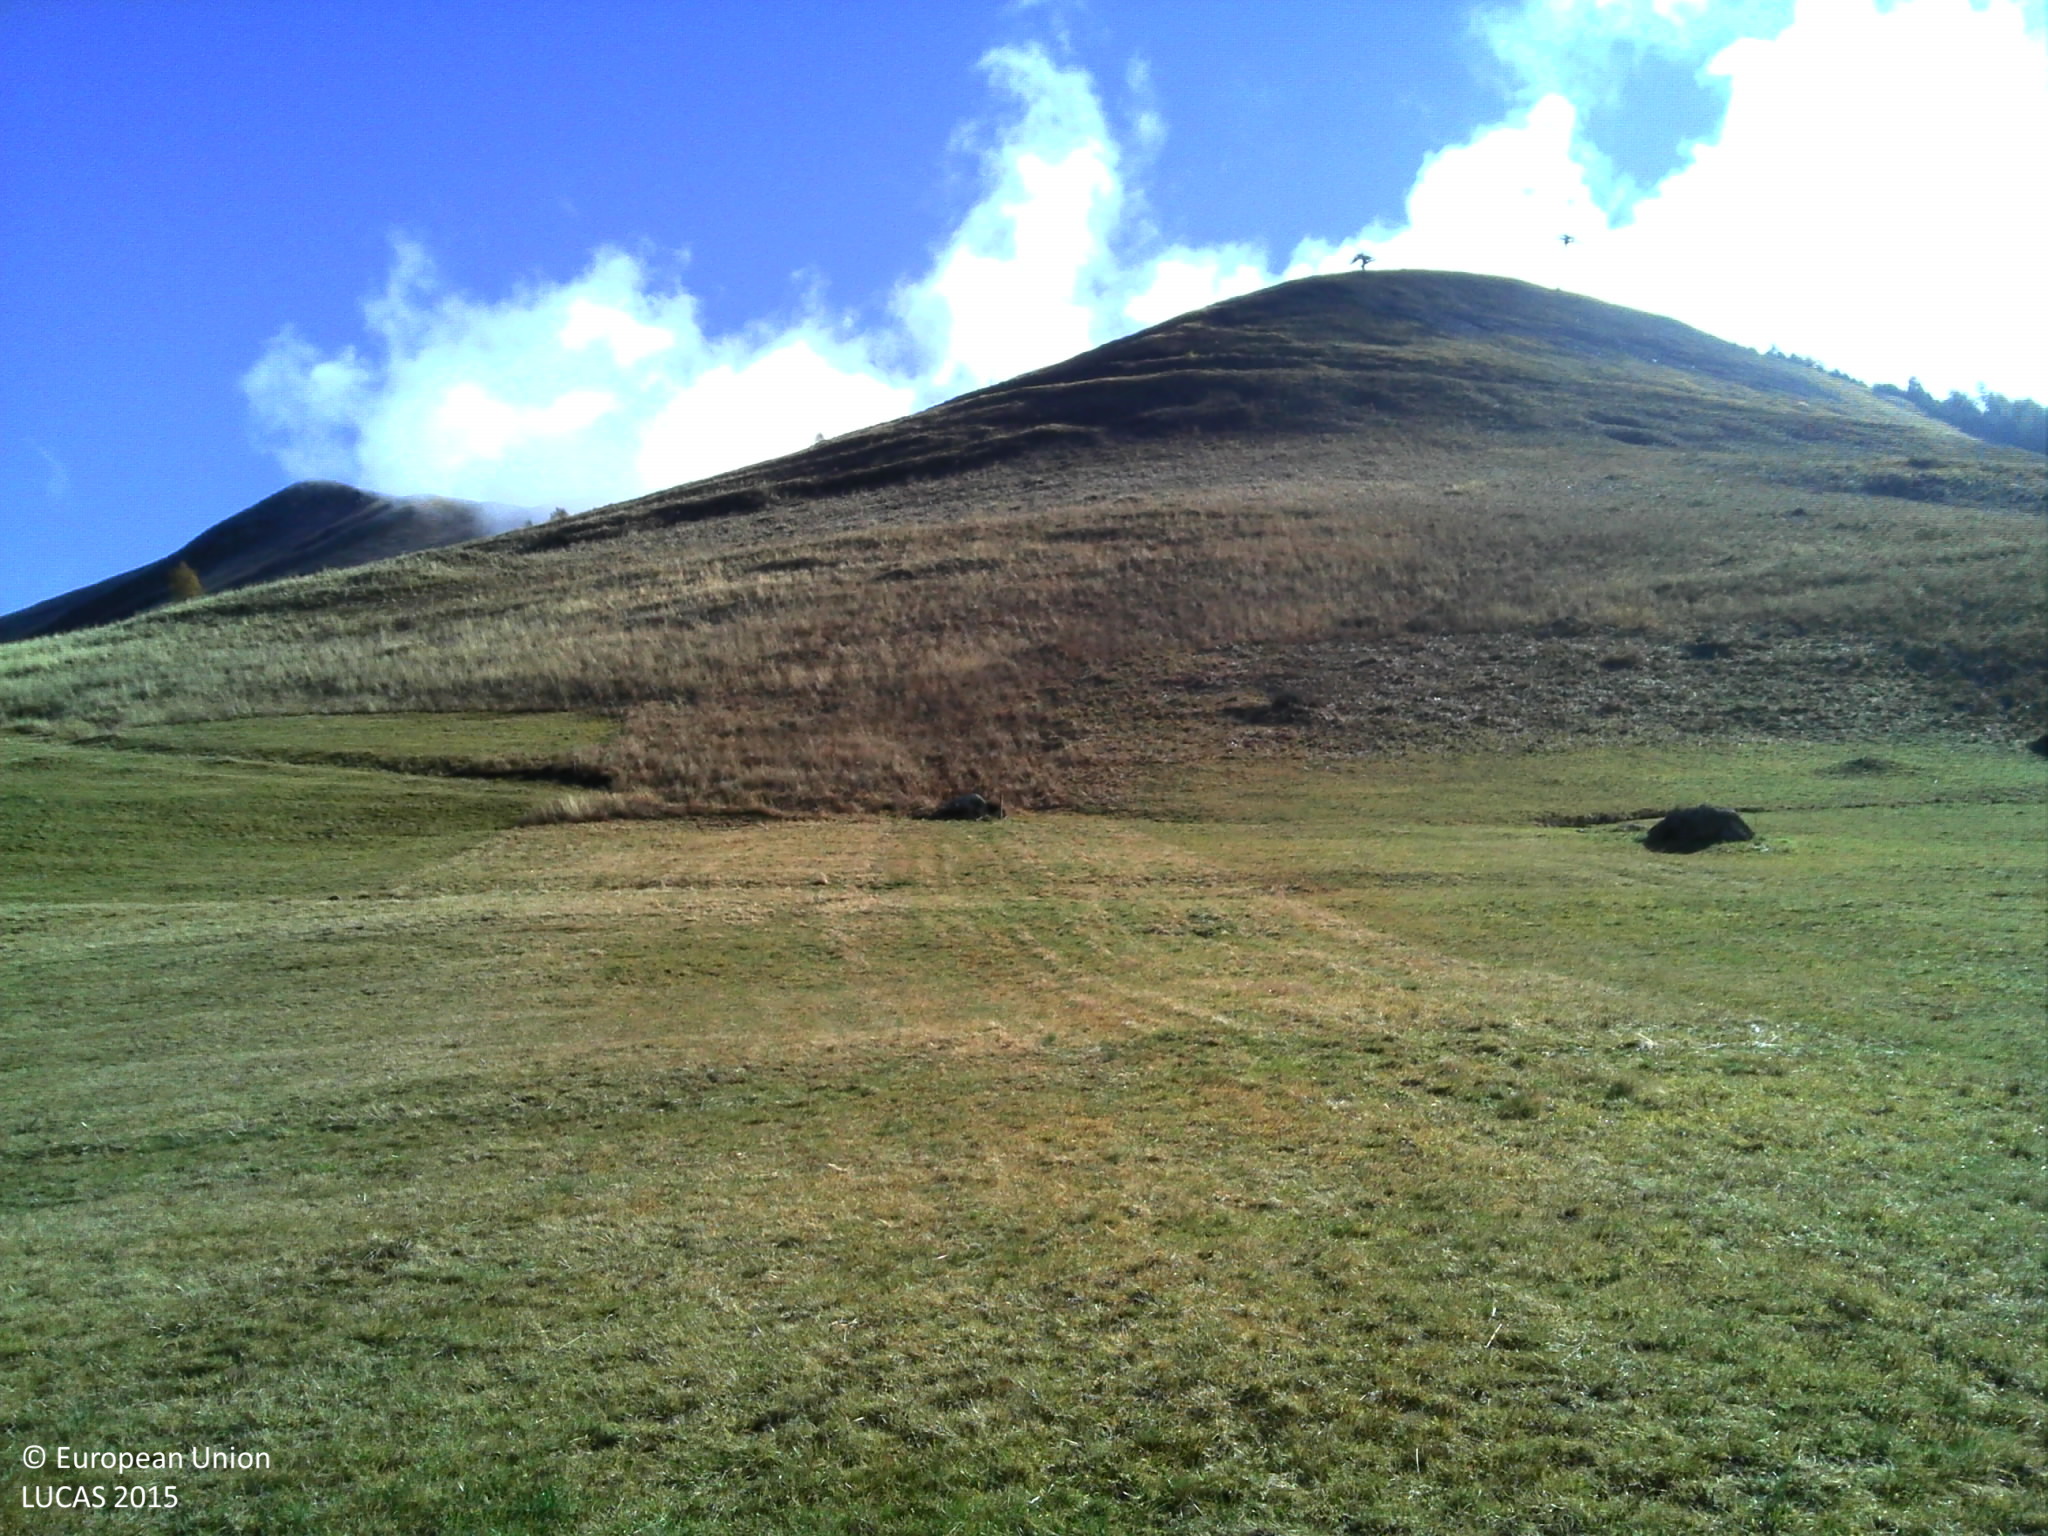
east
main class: Grassland
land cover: Grassland without tree/shrub cover
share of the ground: > 75 %
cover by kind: herbaceous plants 95 %, unconsolidated bare surface 5 %
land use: Agriculture (excluding fallow land and kitchen gardens)
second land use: Sport
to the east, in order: Grassland without tree/shrub cover; Tracks; Grassland without tree/shrub cover
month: October
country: FR
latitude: 45.0602
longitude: 6.2846
